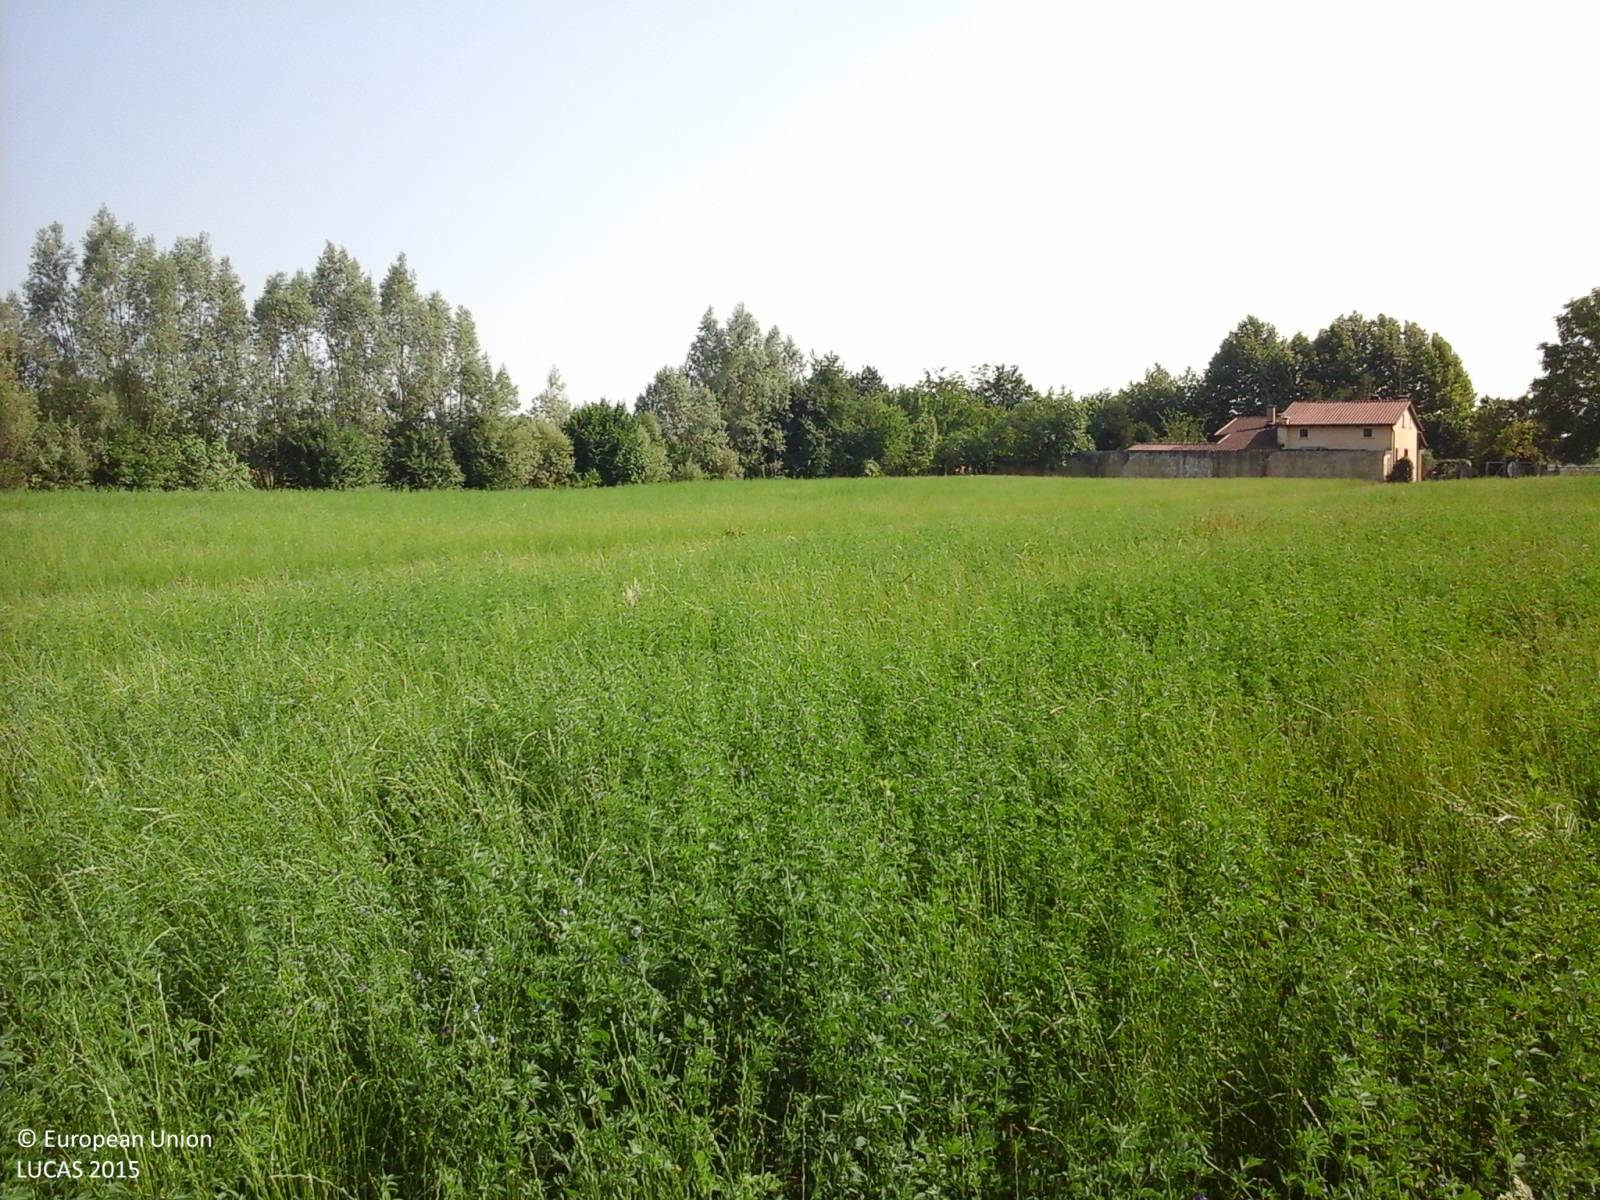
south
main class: Cropland
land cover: Lucerne
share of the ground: > 75 %
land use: Agriculture (excluding fallow land and kitchen gardens)
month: June
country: IT
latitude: 45.9221
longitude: 12.6399
